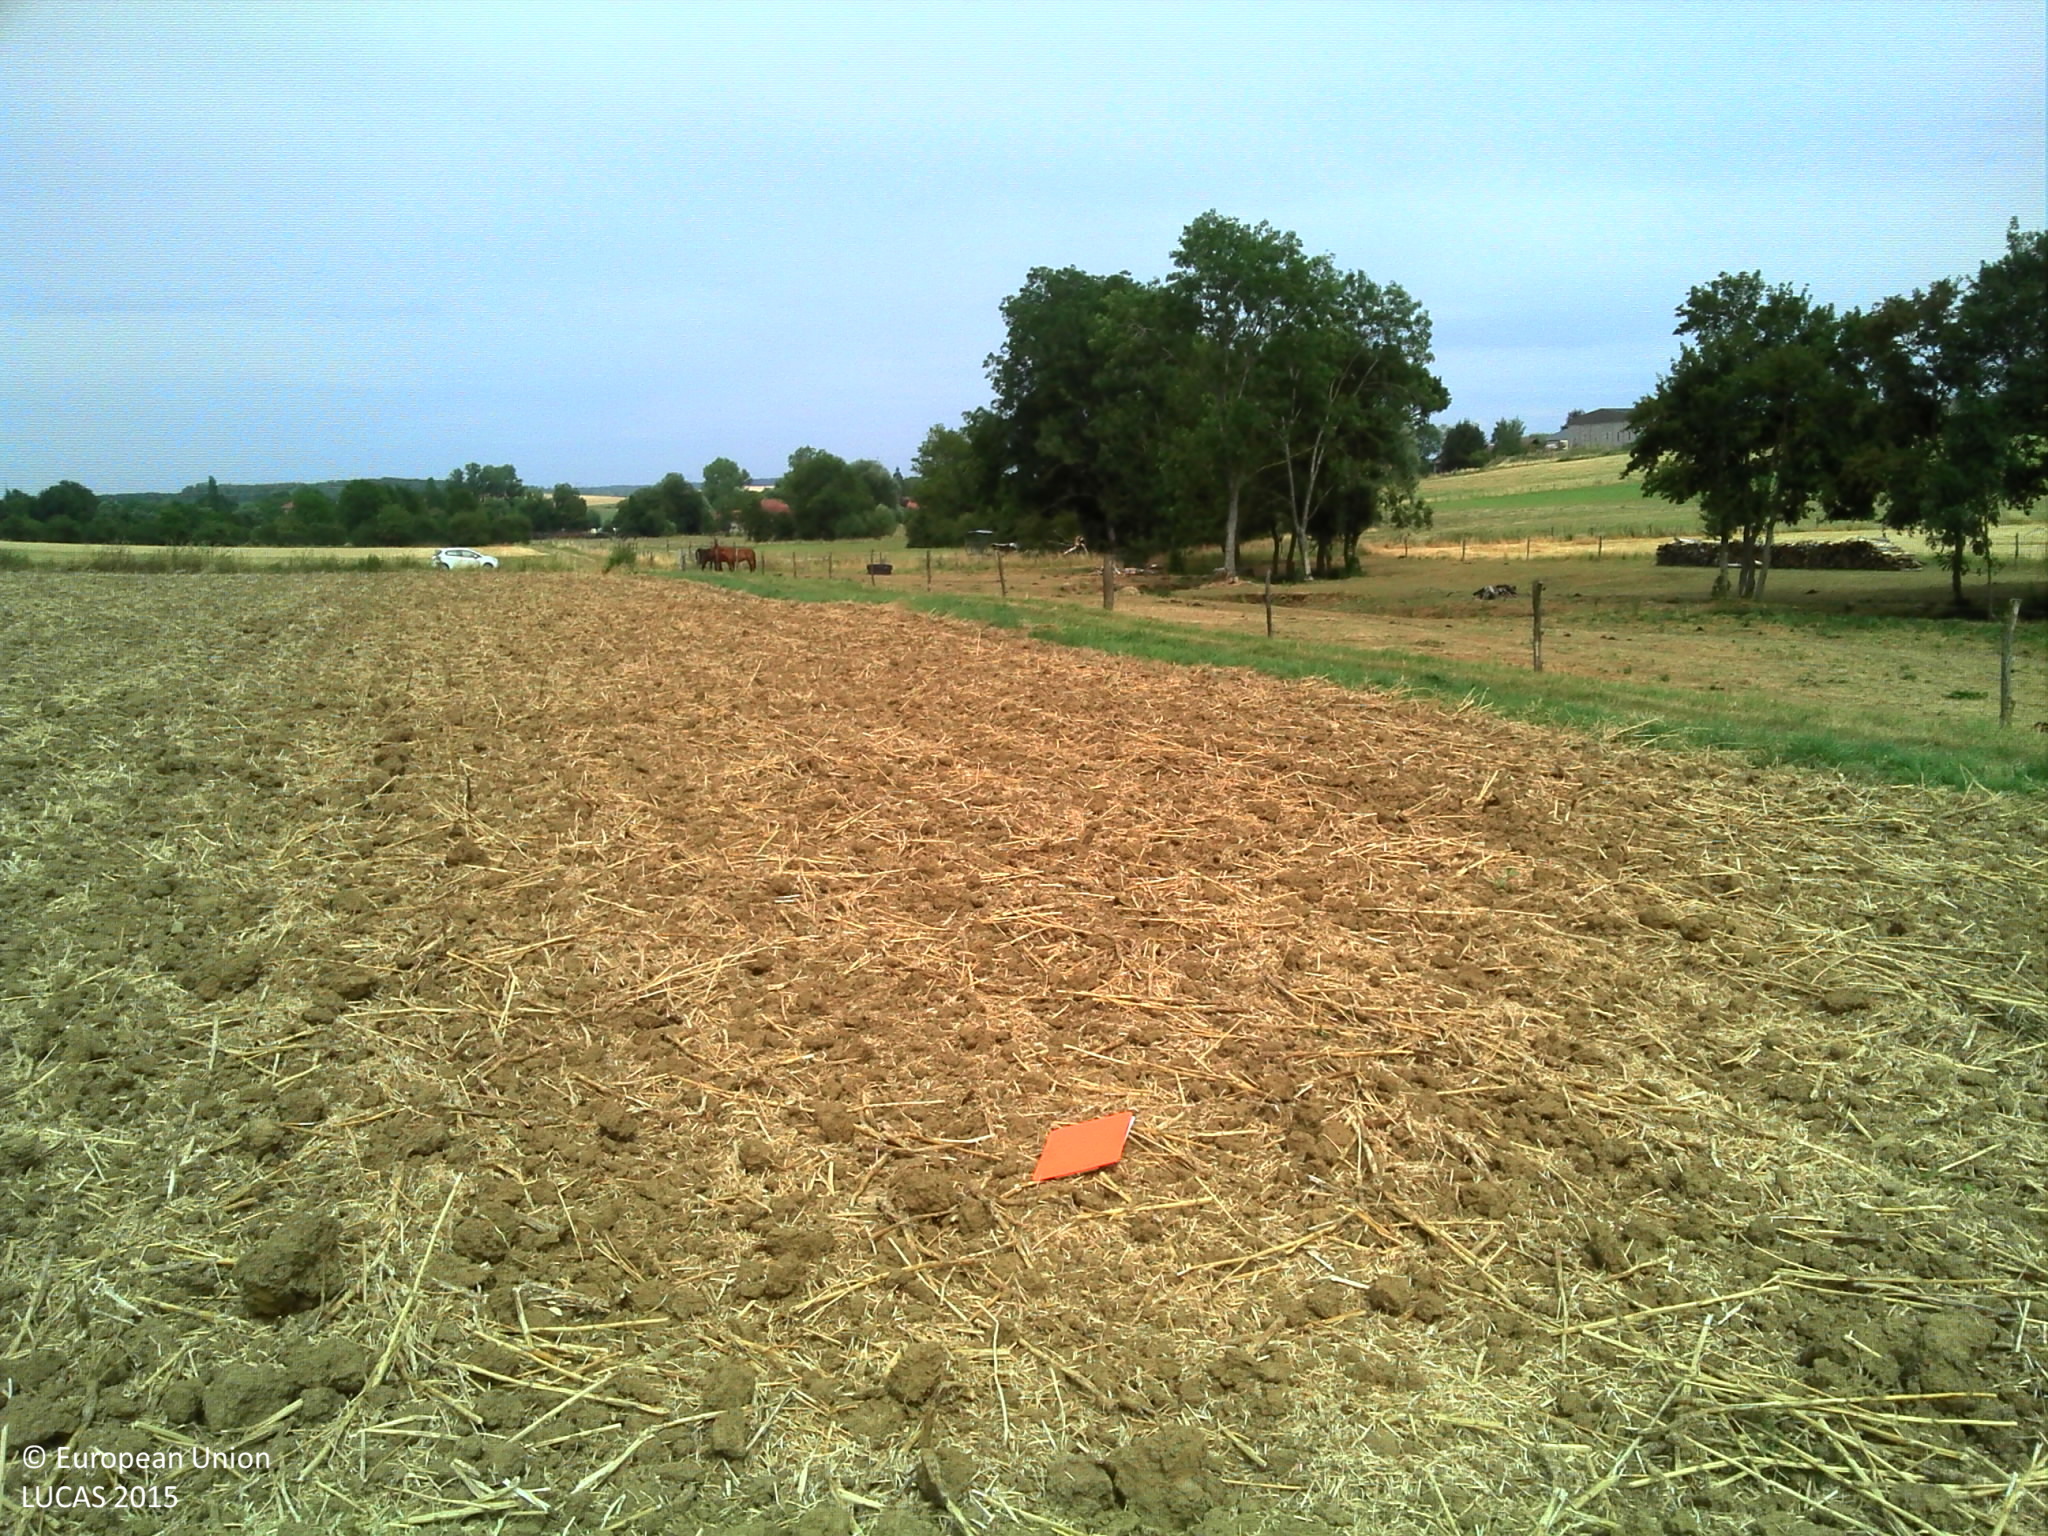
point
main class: Cropland
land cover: Rape and turnip rape
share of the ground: > 75 %
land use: Agriculture (excluding fallow land and kitchen gardens)
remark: Harvested field
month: July
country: FR
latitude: 48.3896
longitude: 6.1245
